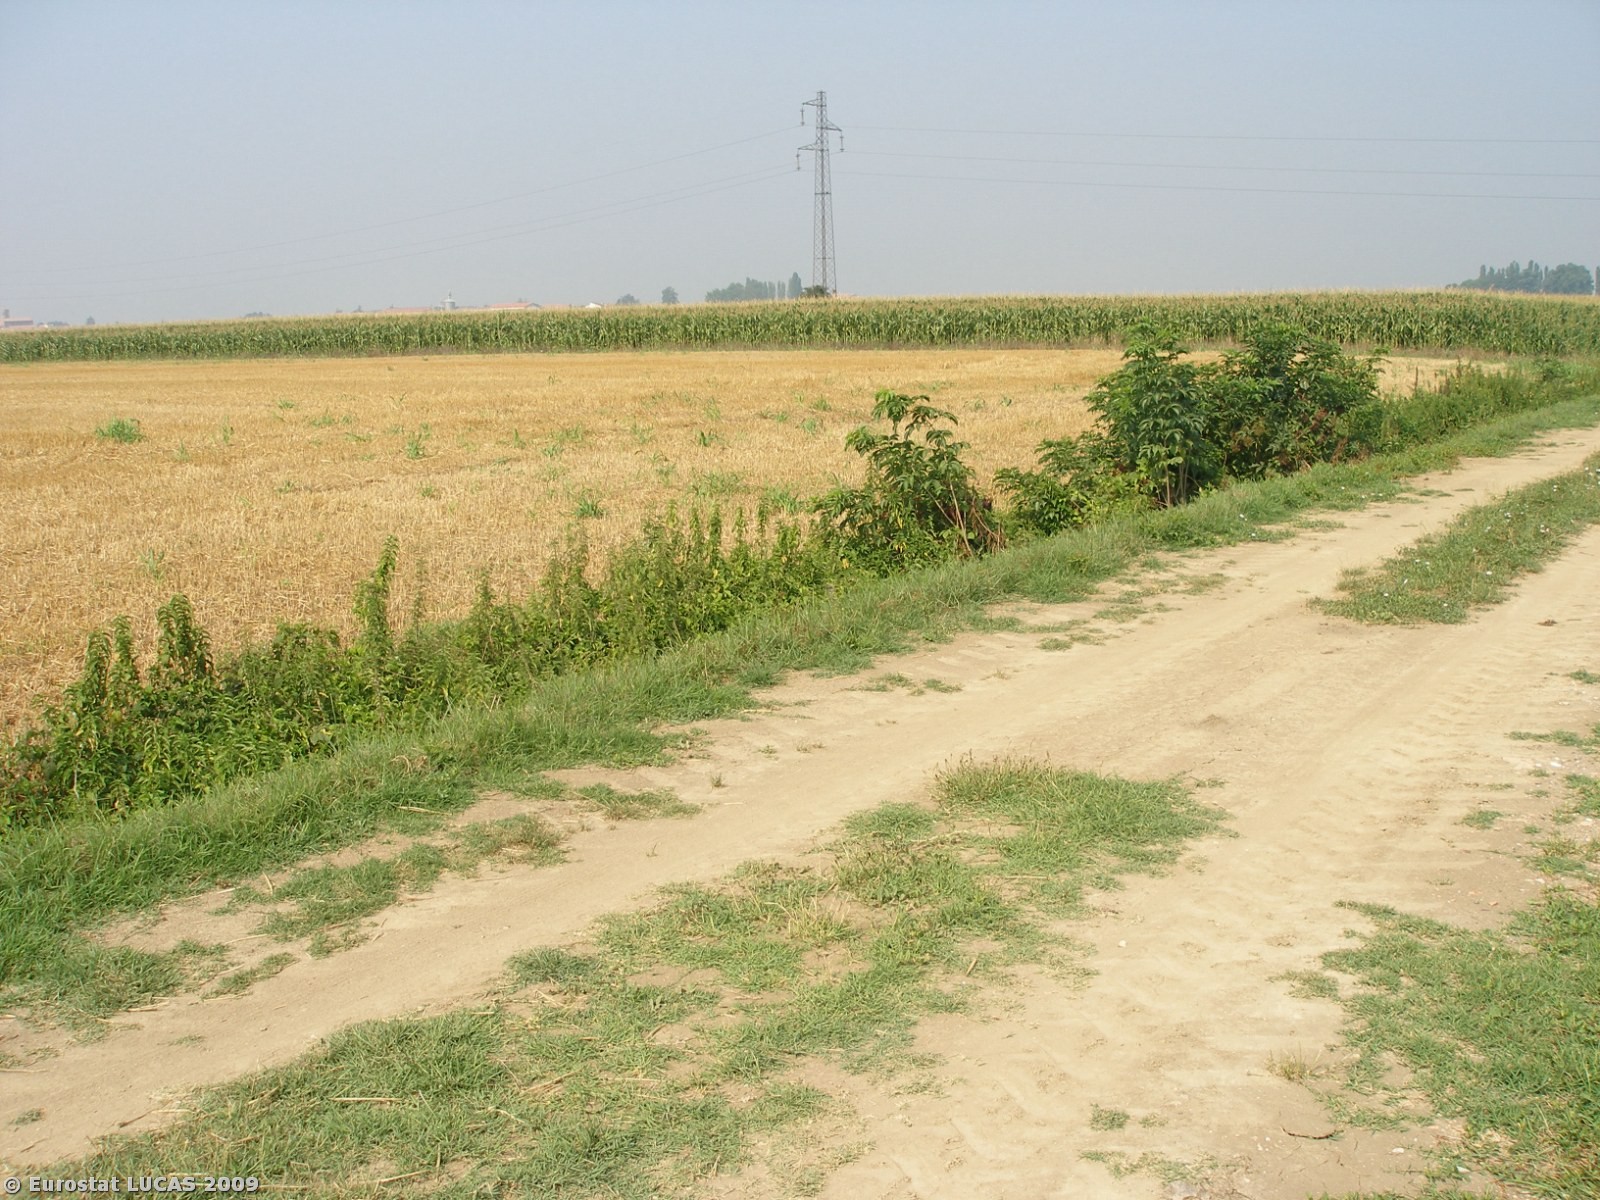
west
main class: Cropland
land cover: Maize
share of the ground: > 75 %
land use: Agriculture (excluding fallow land and kitchen gardens)
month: July
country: IT
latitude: 44.9858
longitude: 11.7089
